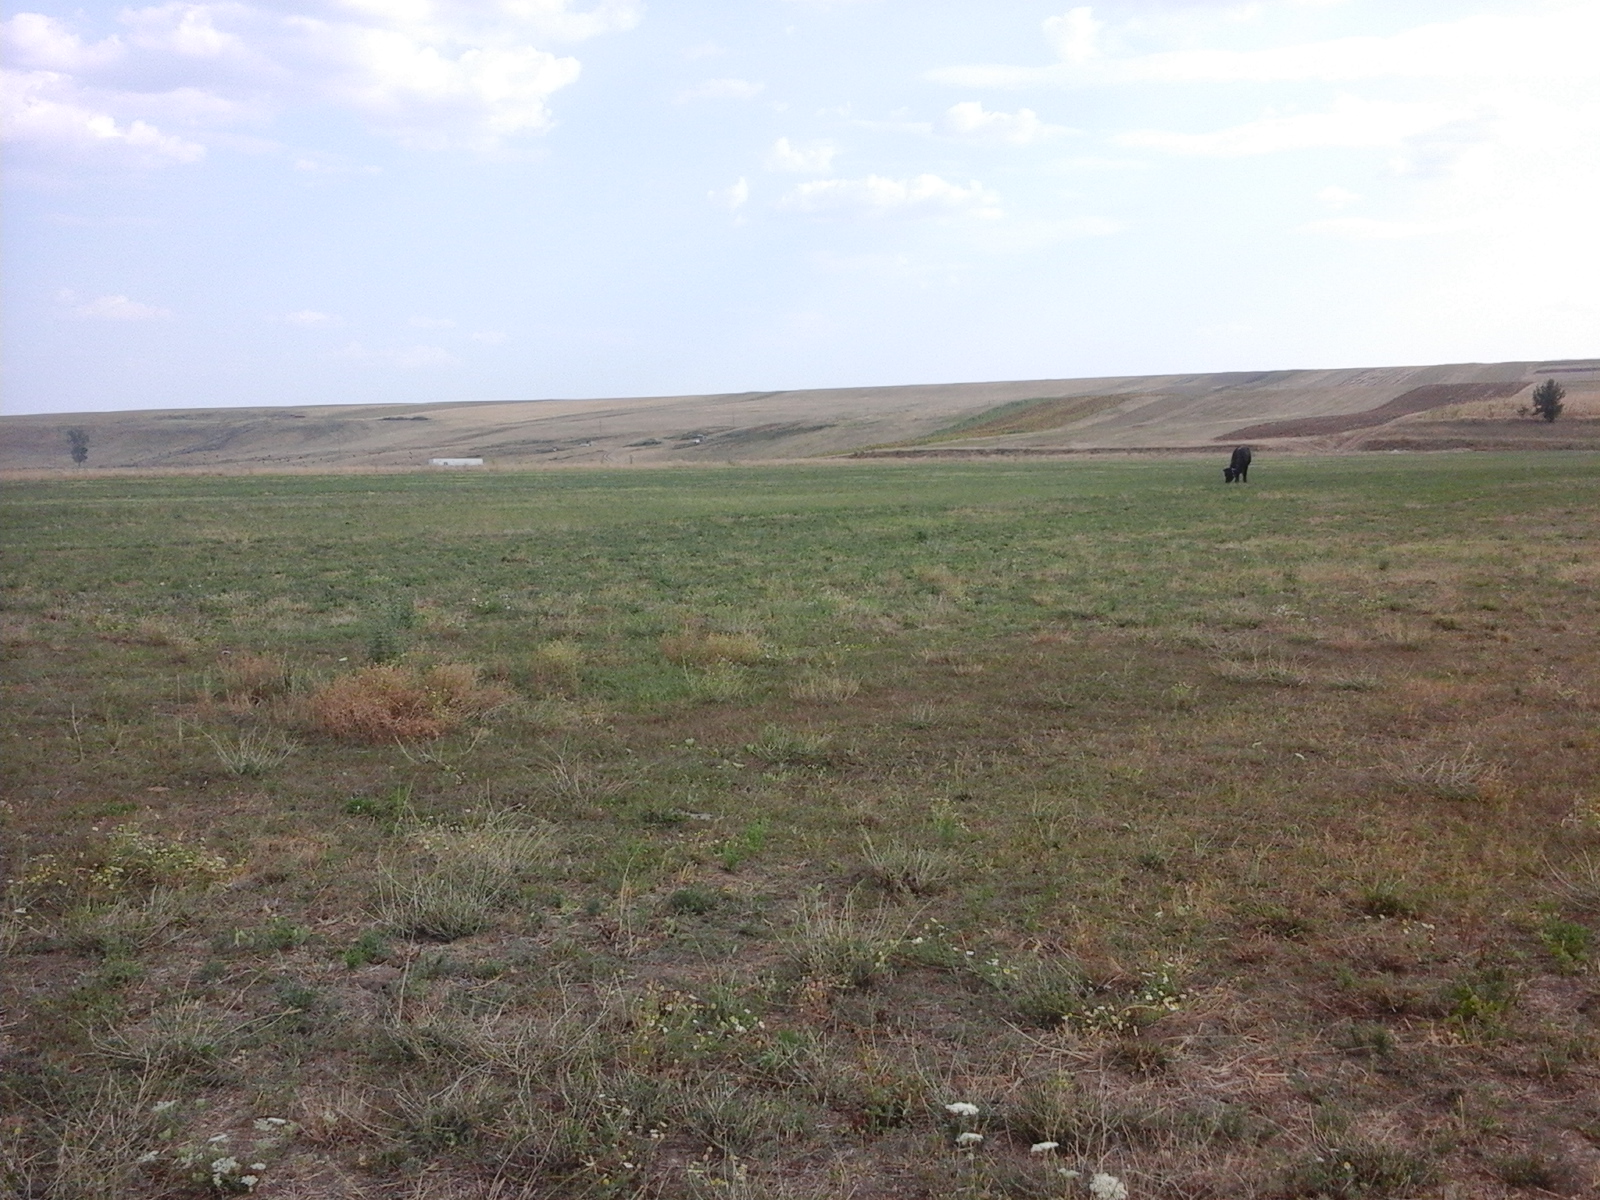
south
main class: Grassland
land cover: Grassland without tree/shrub cover
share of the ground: > 75 %
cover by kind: herbaceous plants 100 %
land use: Agriculture (excluding fallow land and kitchen gardens)
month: August
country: RO
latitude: 44.2972
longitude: 23.2710
